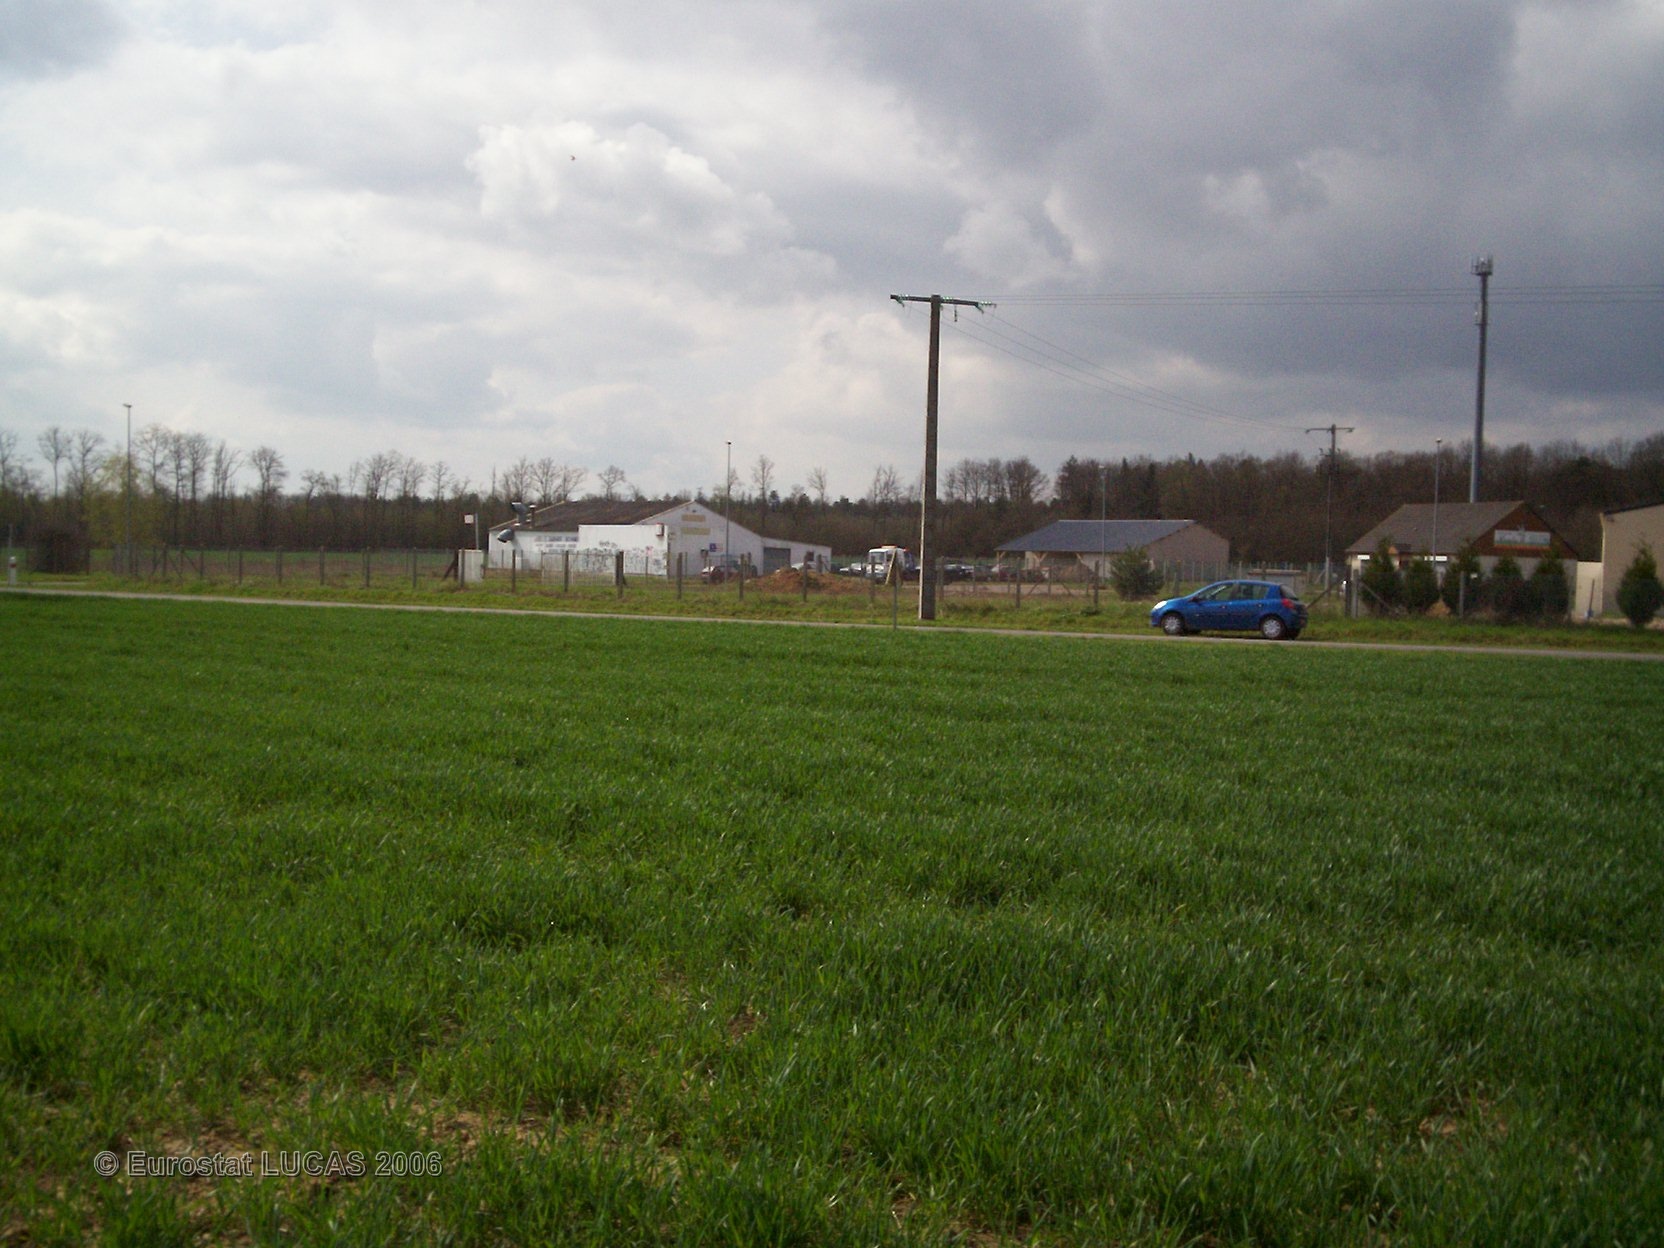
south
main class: Cropland
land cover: Common wheat
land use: Agriculture (excluding fallow land and kitchen gardens)
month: April
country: FR
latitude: 48.9973
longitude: 1.0260
